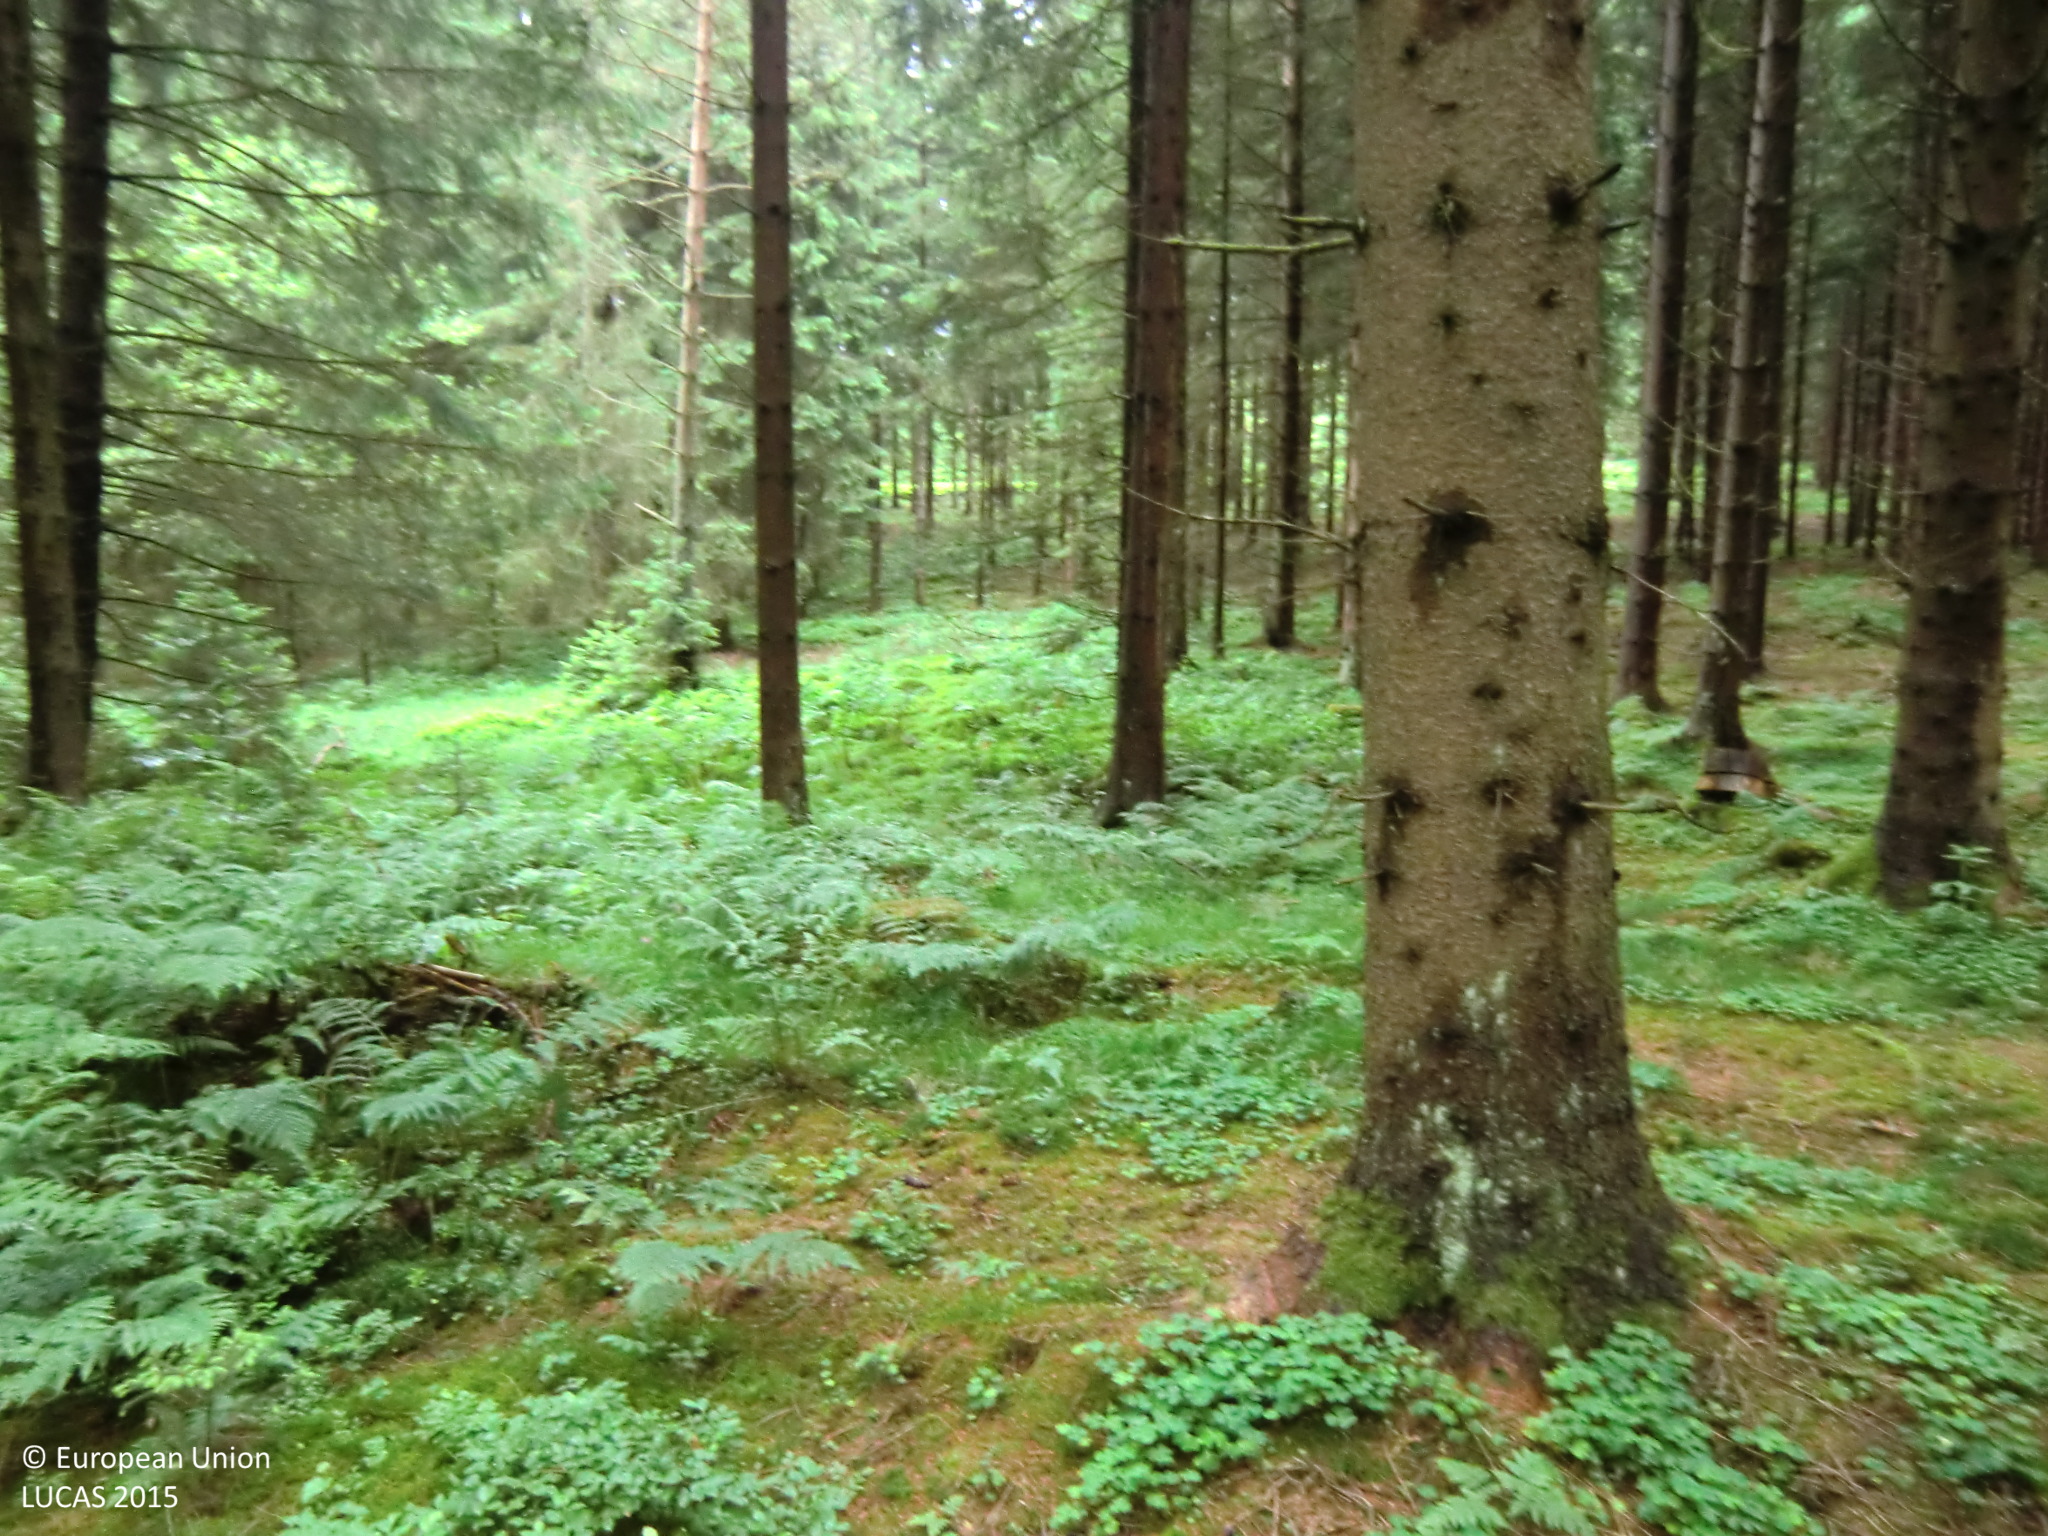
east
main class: Woodland
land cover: Spruce dominated coniferous woodland
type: hemiboreal forest and nemoral coniferous forest and mixed broadleaved-coniferous forest
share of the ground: > 75 %
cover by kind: coniferous forest trees 75 %, herbaceous plants 15 %, lichens and mosses 10 %
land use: Forestry
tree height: > 5 m
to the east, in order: Spruce dominated coniferous woodland; Tracks; Shrubland with sparse tree cover; Spruce dominated coniferous woodland; Grassland without tree/shrub cover; Grassland with sparse tree/shrub cover; Temporary grasslands
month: June
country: AT
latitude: 48.4661
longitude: 14.6940
